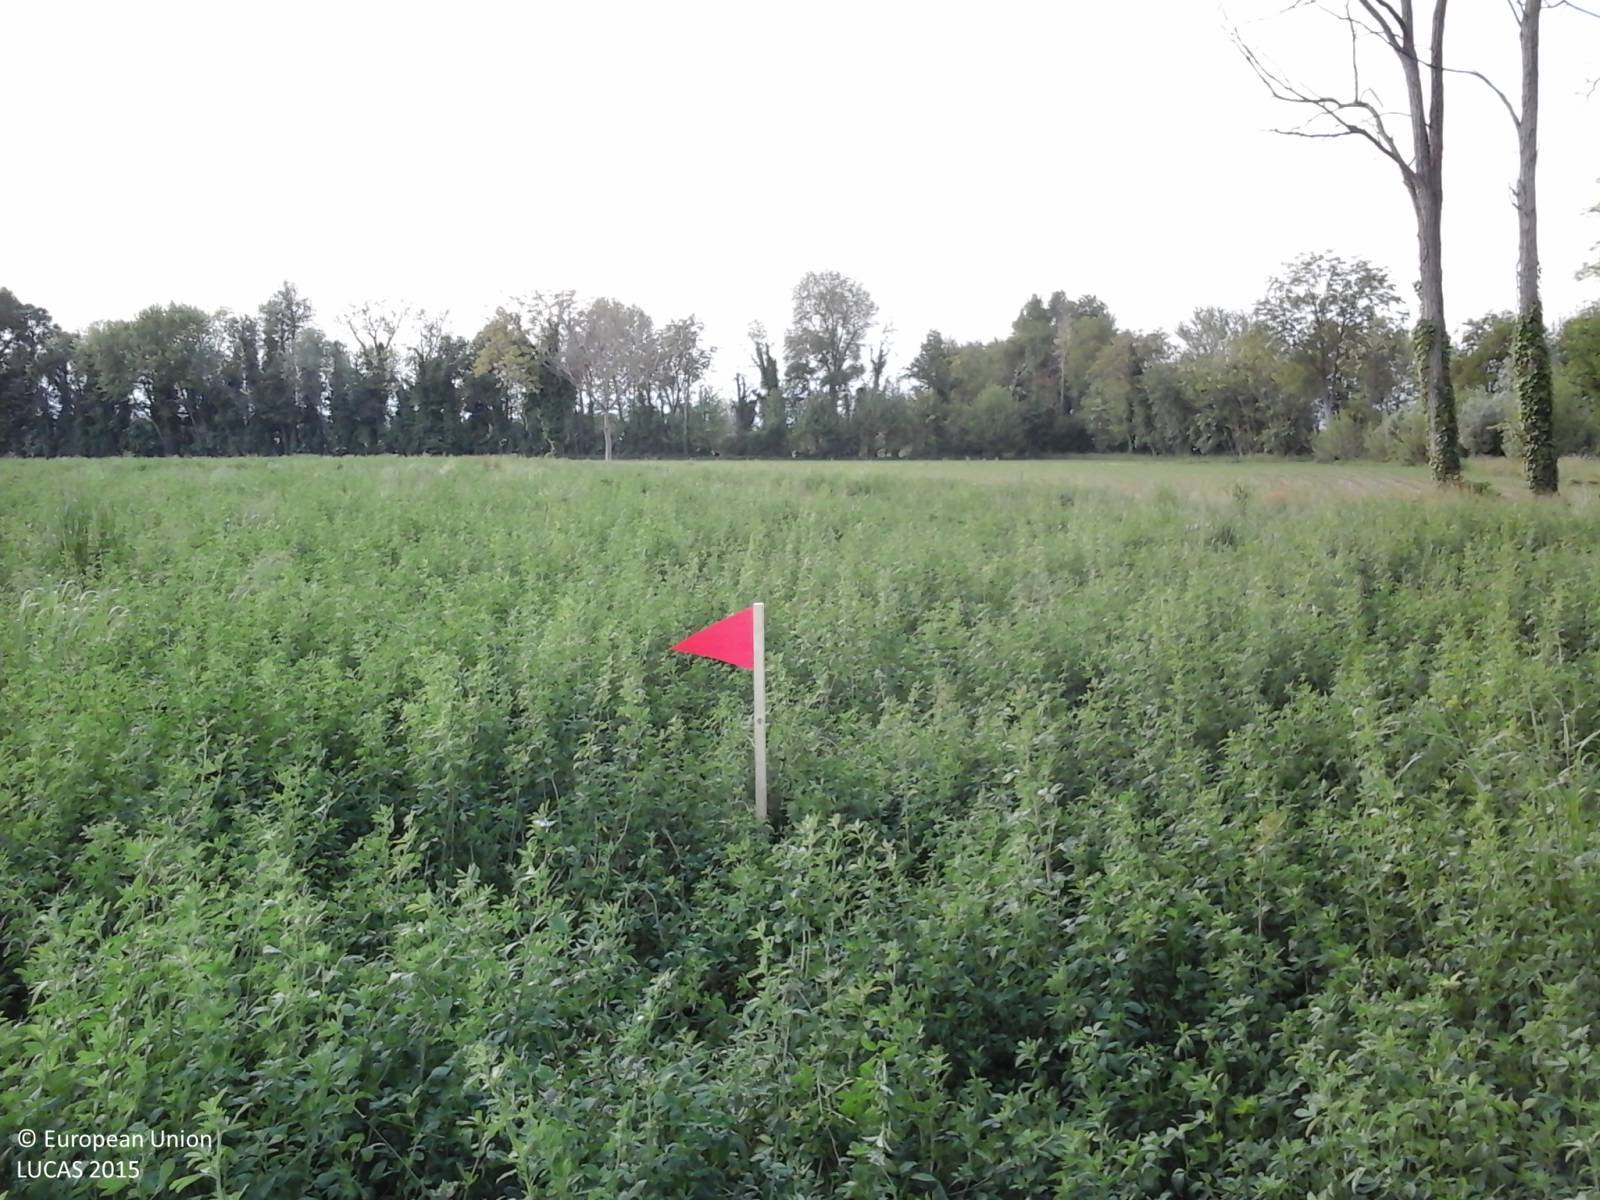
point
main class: Cropland
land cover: Lucerne
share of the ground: > 75 %
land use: Agriculture (excluding fallow land and kitchen gardens)
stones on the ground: 25 - 50 %
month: May
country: IT
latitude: 45.9133
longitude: 12.9745
